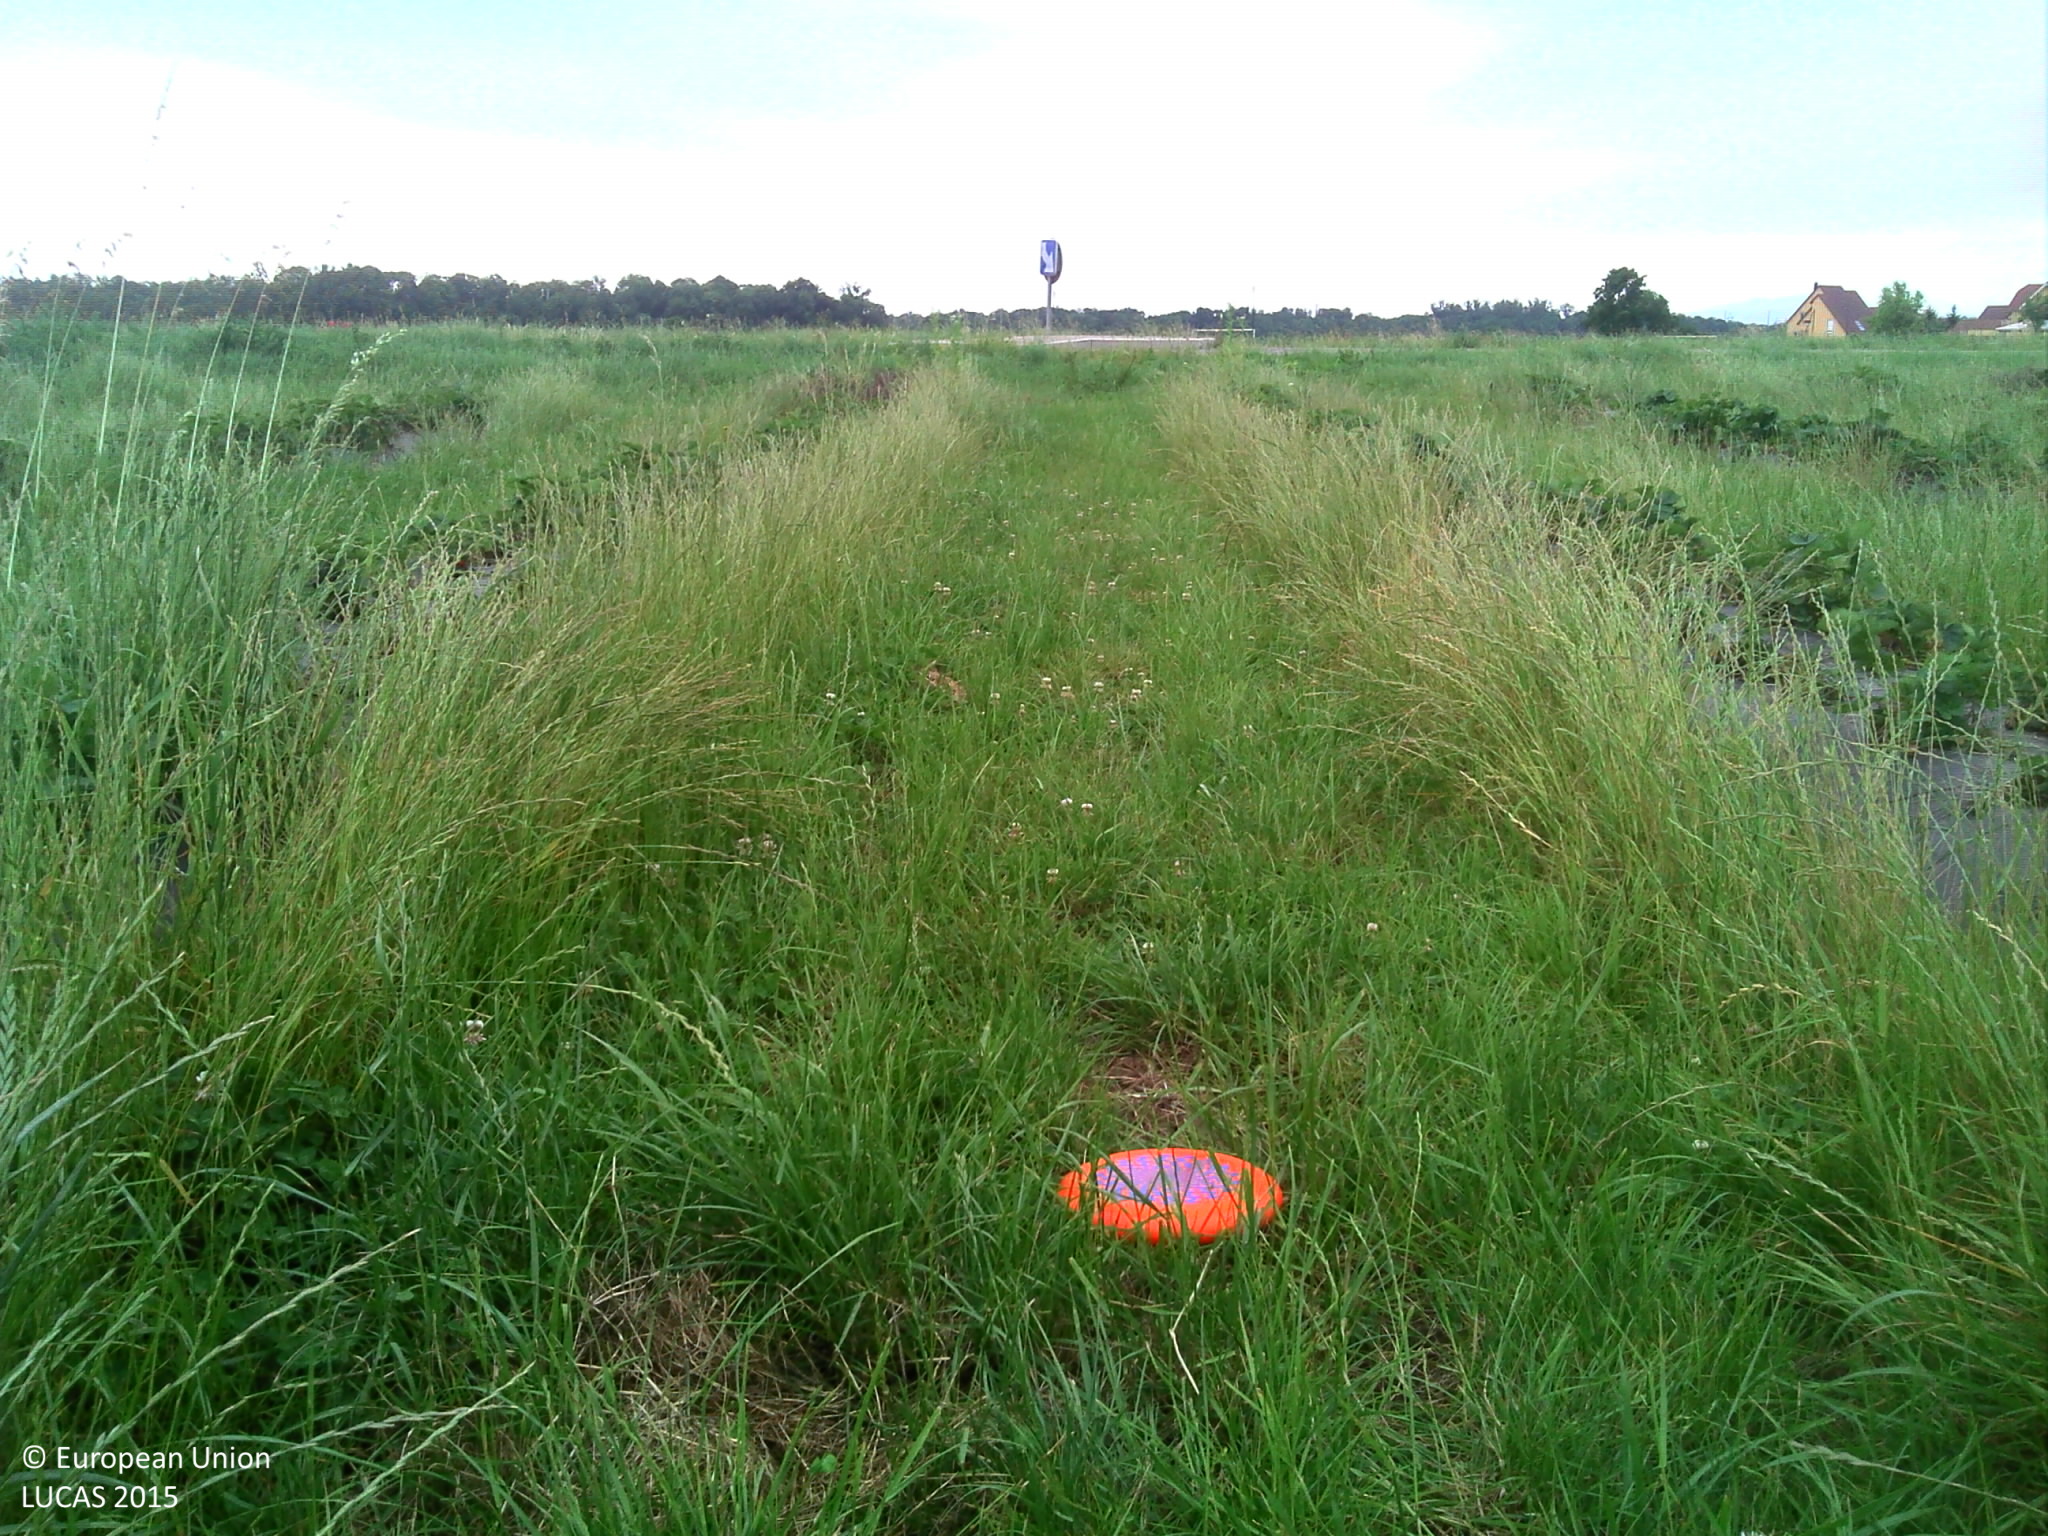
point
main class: Cropland
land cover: Strawberries
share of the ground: 50 - 75 %
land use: Agriculture (excluding fallow land and kitchen gardens)
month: June
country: FR
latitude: 48.4485
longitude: 7.5538
